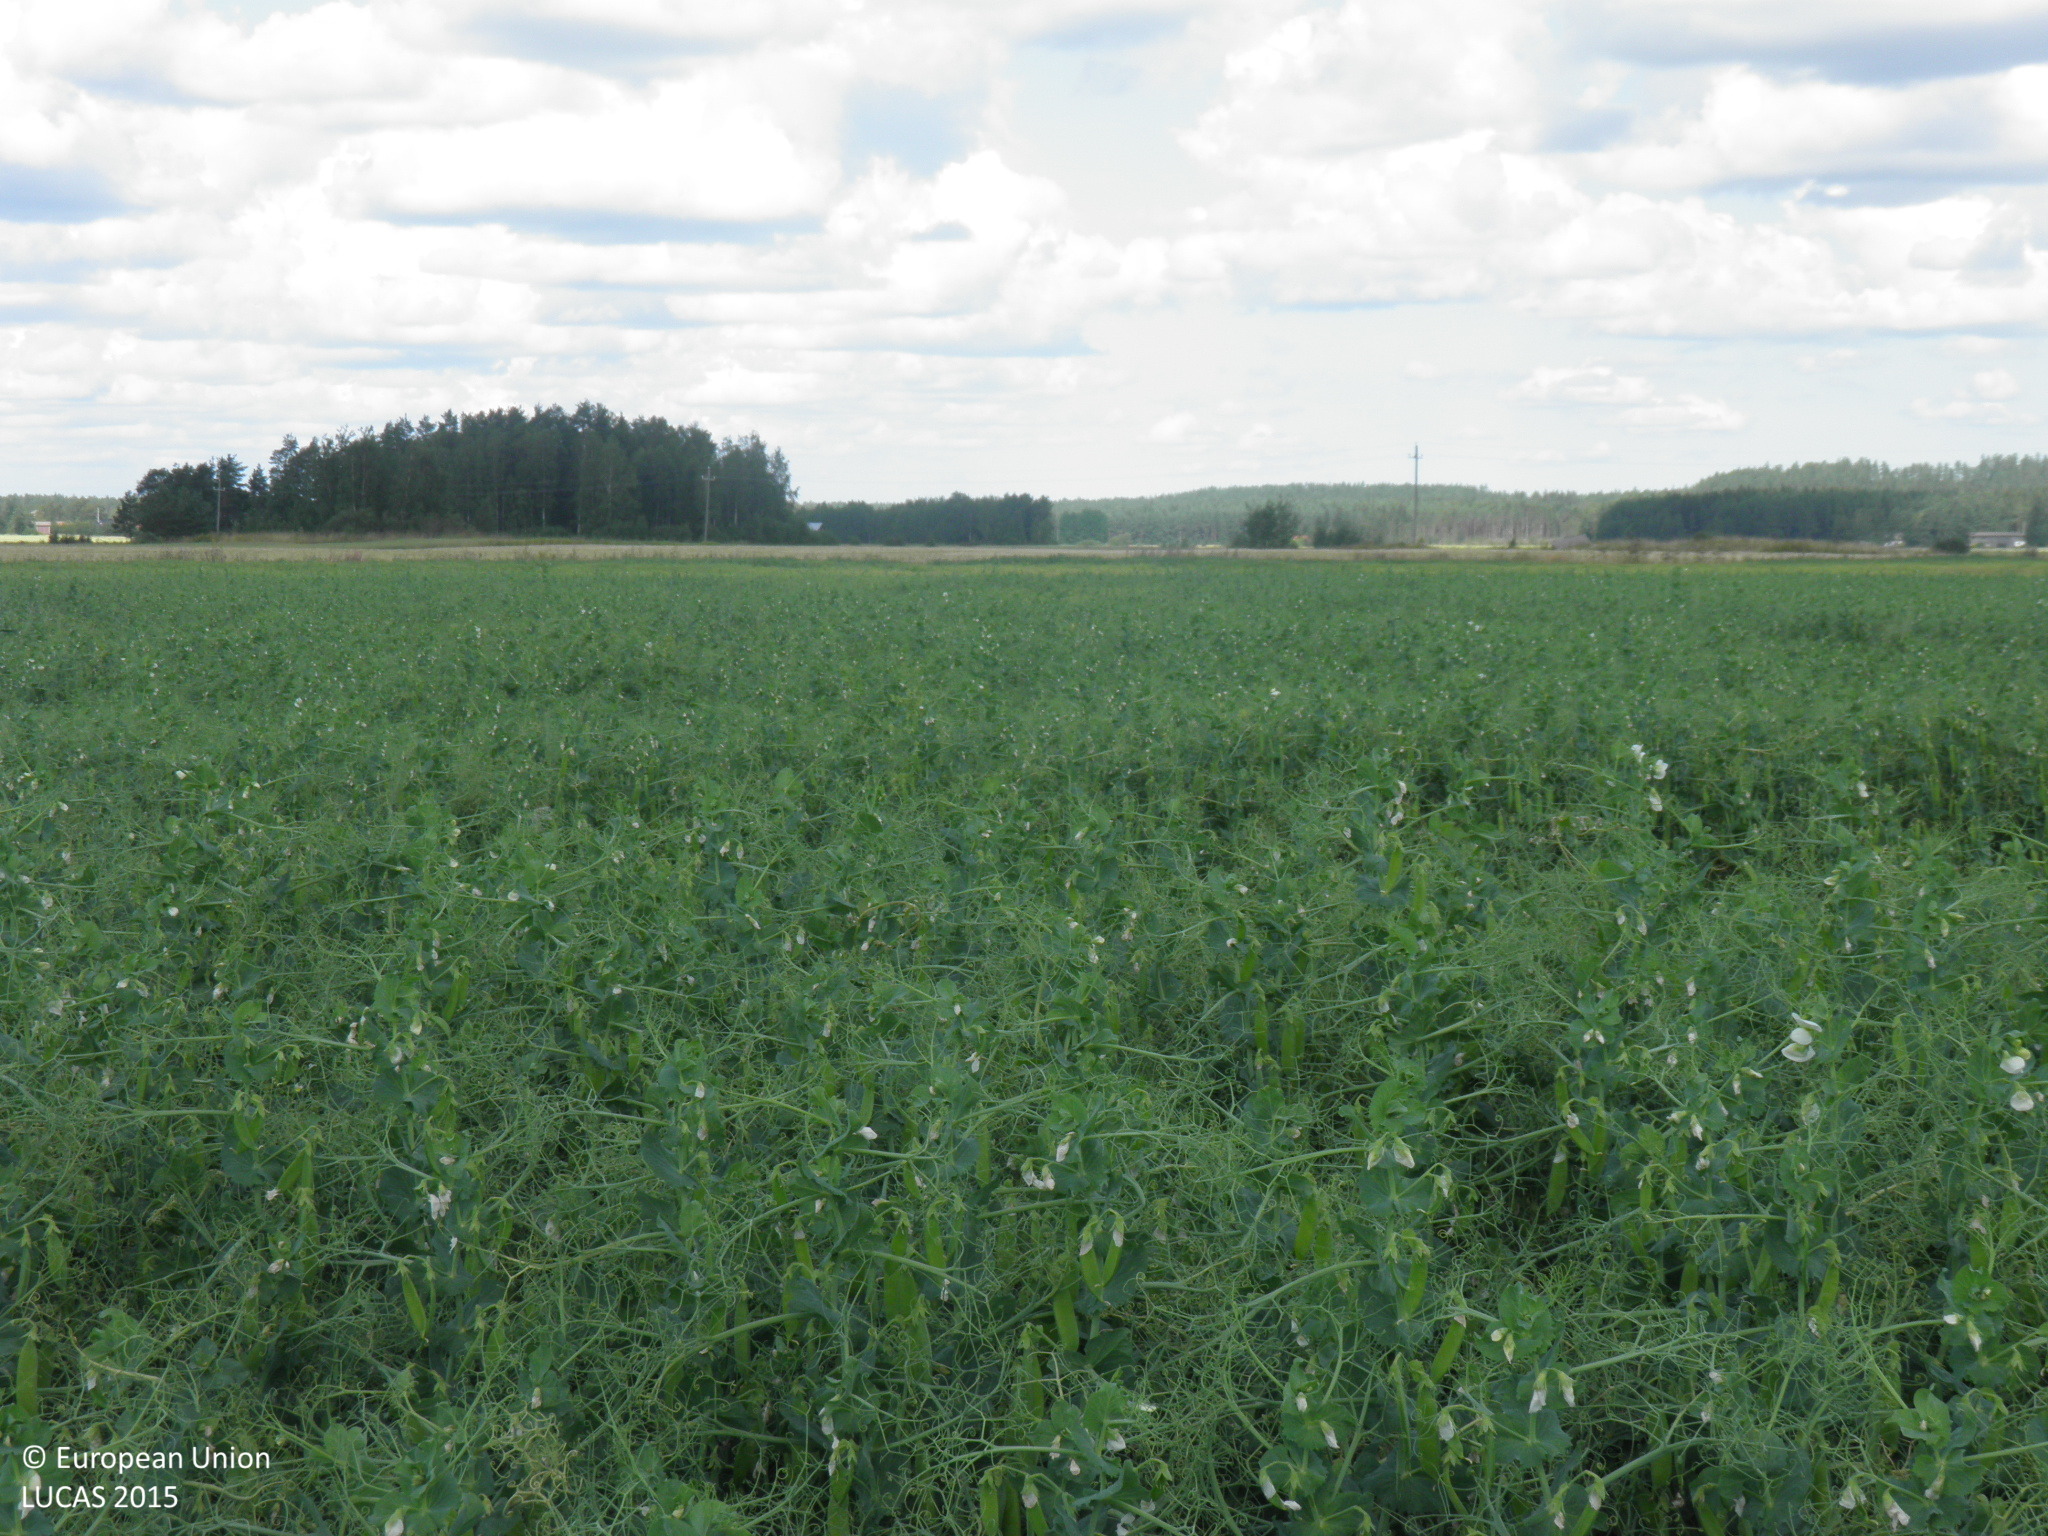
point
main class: Cropland
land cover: Dry pulses
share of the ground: > 75 %
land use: Agriculture (excluding fallow land and kitchen gardens)
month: August
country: FI
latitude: 61.0347
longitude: 21.9993
